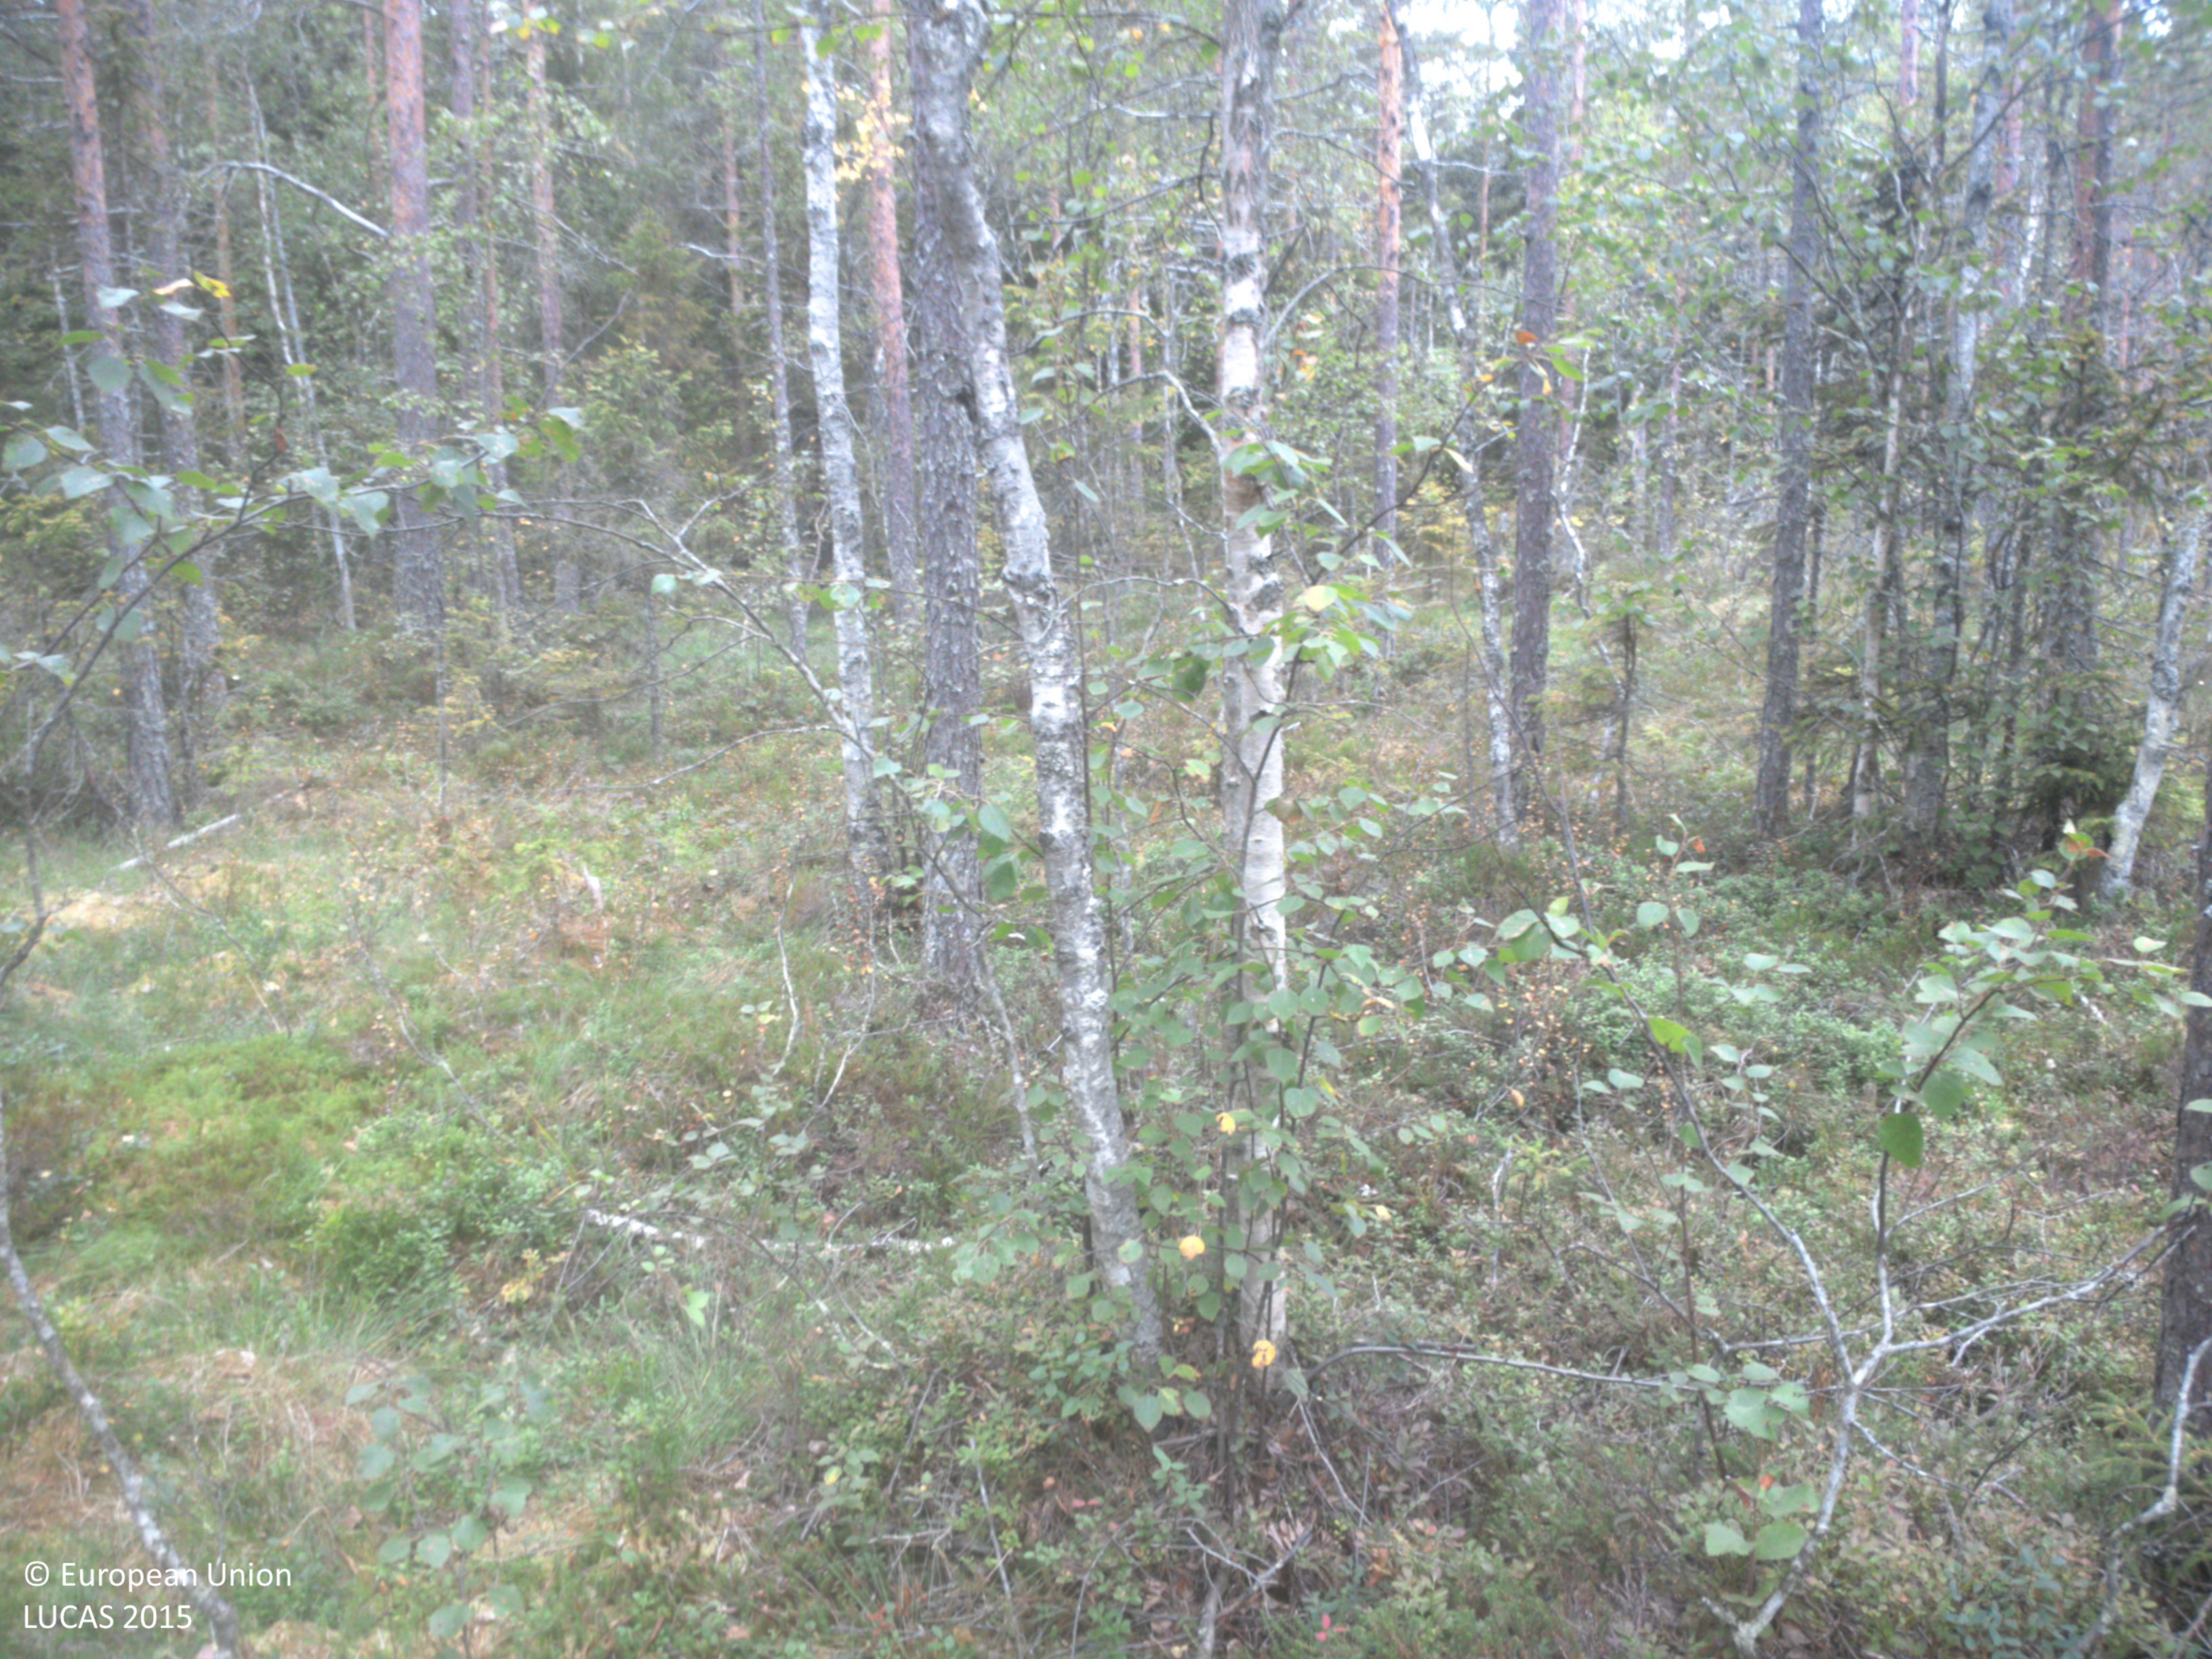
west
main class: Woodland
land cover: Pine dominated mixed woodland
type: boreal forest
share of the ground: 50 - 75 %
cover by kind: coniferous forest trees 40 %, shrubs 40 %, broadleaved forest trees 20 %
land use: Forestry
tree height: > 5 m
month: August
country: SE
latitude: 63.7352
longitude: 20.0069
